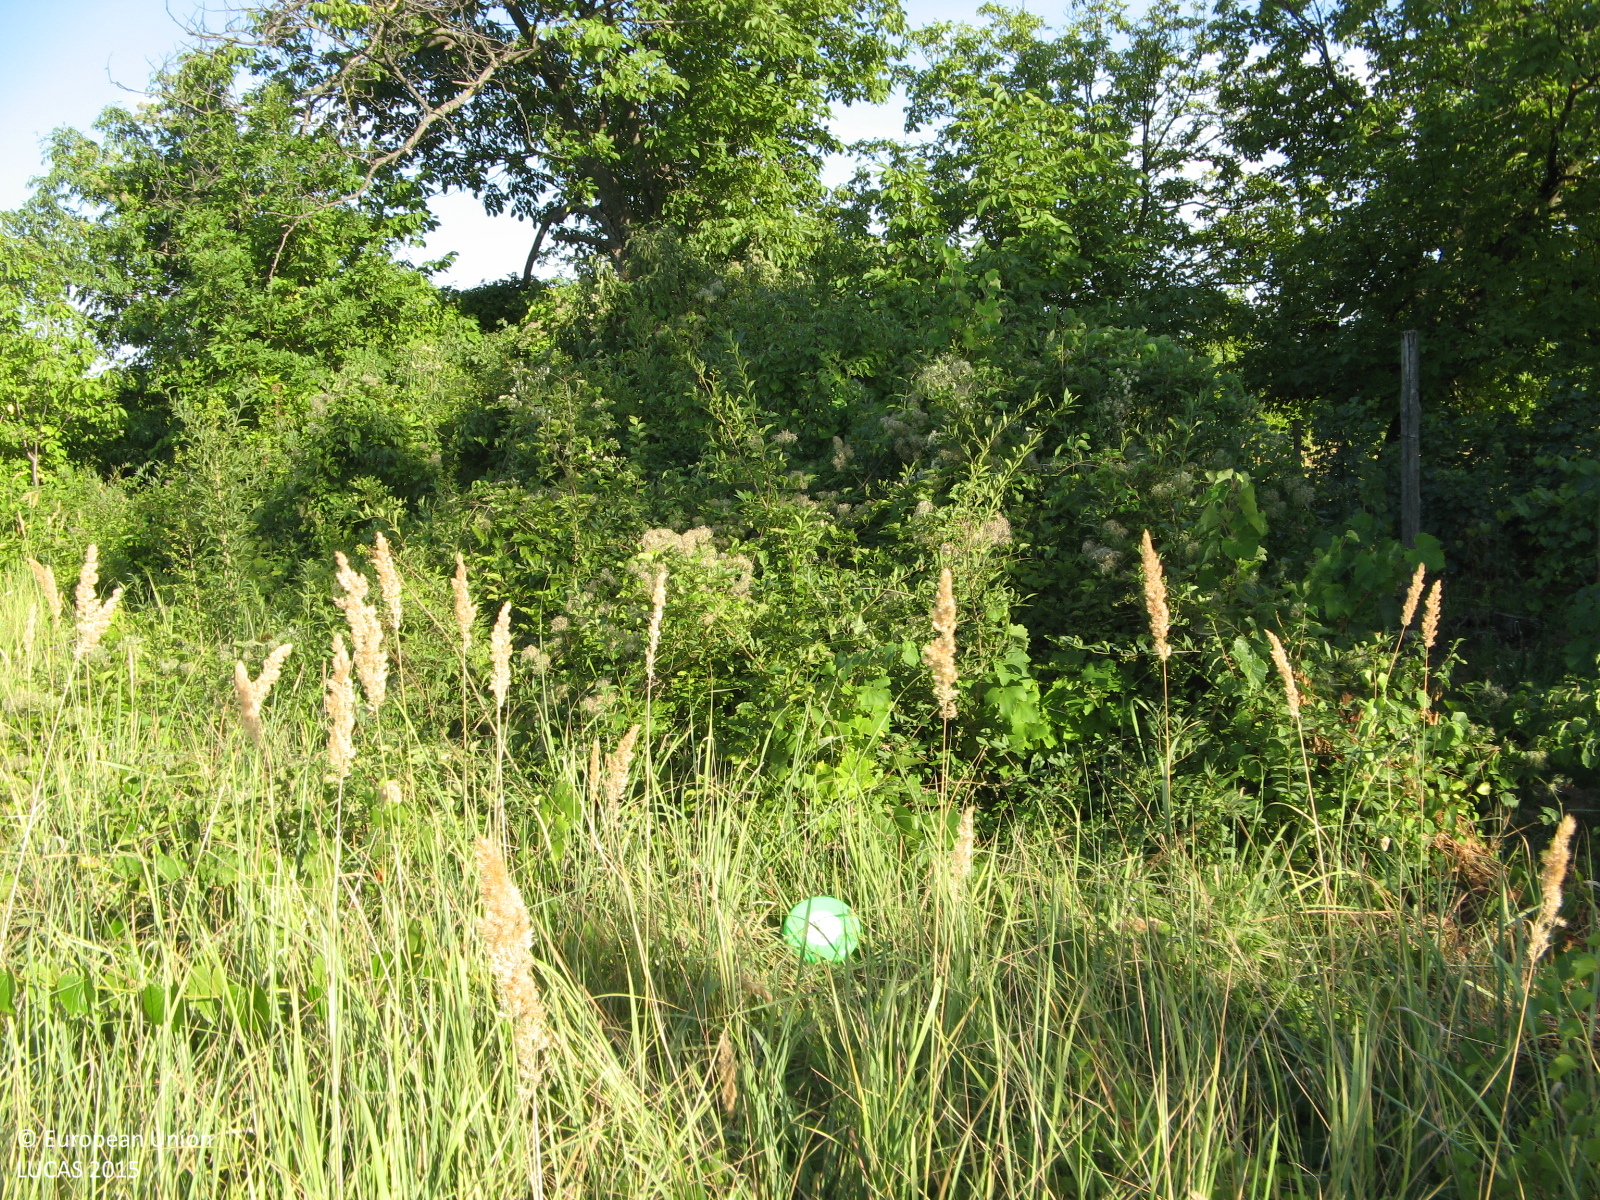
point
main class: Shrubland
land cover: Shrubland with sparse tree cover
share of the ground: 50 - 75 %
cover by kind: shrubs 50 %, herbaceous plants 45 %, broadleaved forest trees 5 %
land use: Semi-natural and natural areas not in use
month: August
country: BG
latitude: 43.6067
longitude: 25.3303
